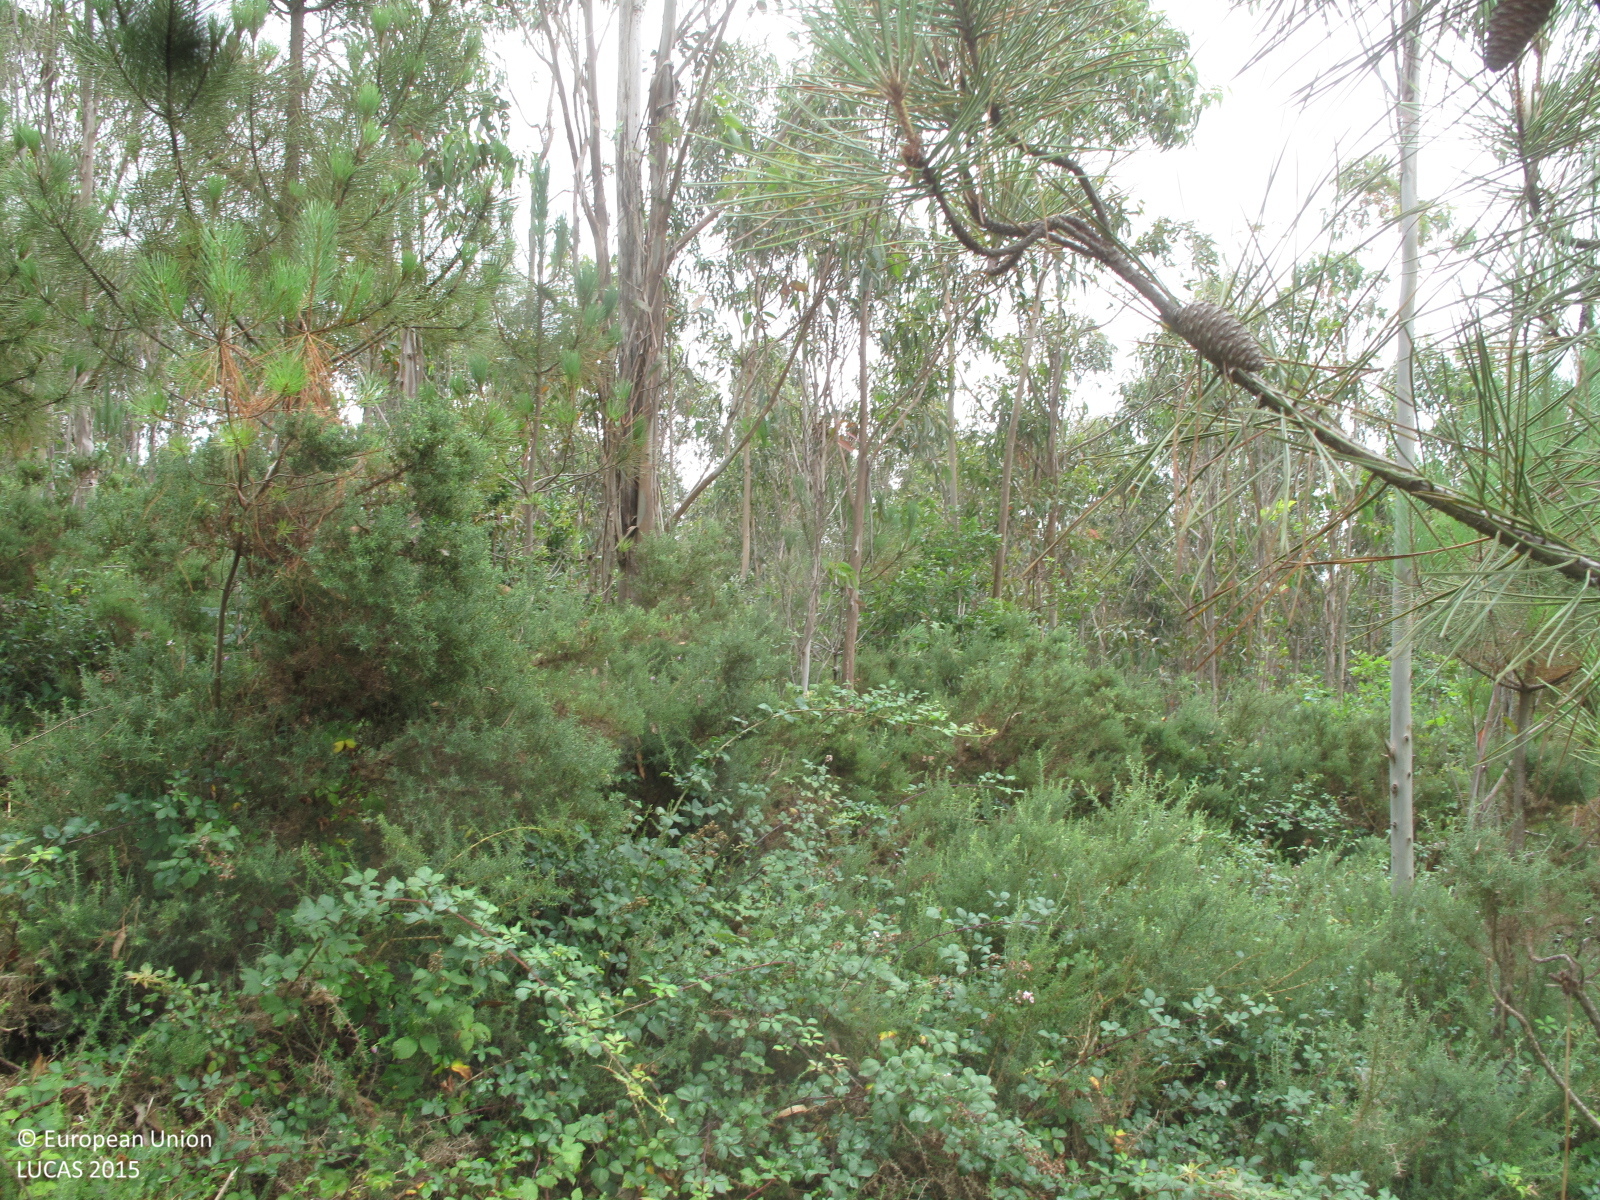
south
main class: Woodland
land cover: Other mixed woodland
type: exotic forest
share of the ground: 50 - 75 %
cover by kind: shrubs 40 %, broadleaved forest trees 30 %, coniferous forest trees 20 %, herbaceous plants 10 %
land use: Forestry
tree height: > 5 m
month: July
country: ES
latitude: 42.9859
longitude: -9.1726
